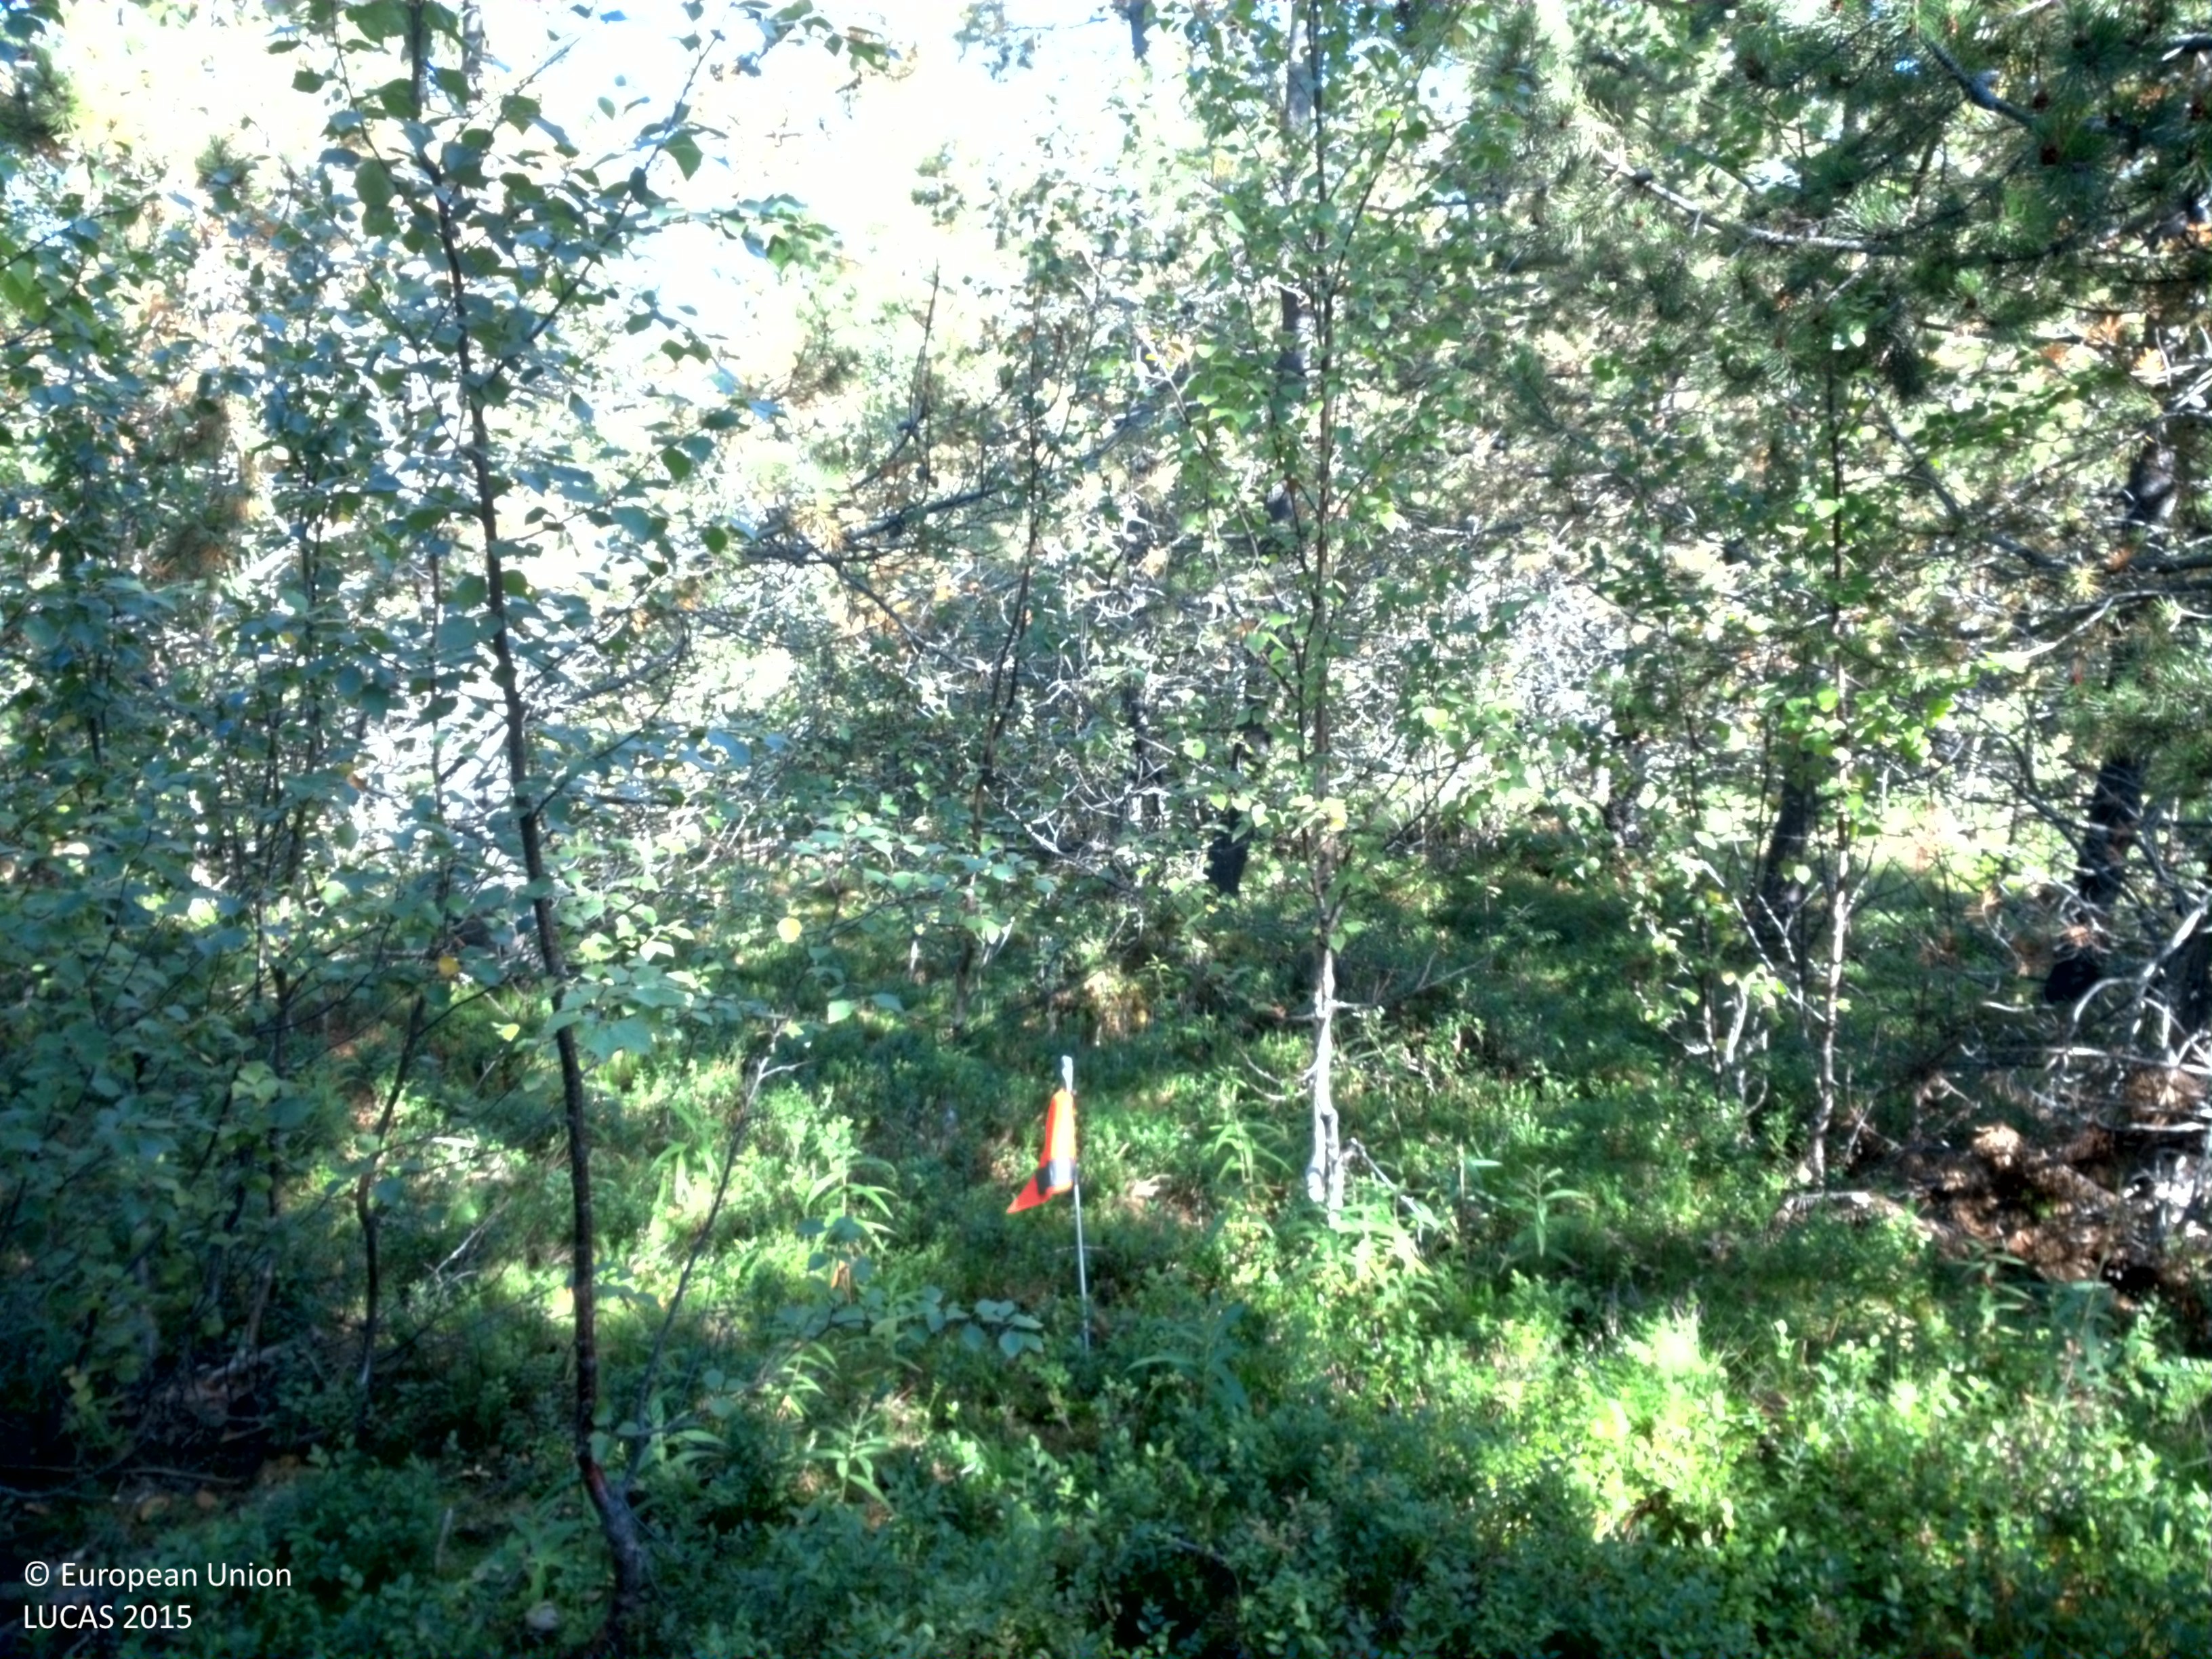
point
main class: Woodland
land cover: Pine dominated mixed woodland
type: exotic forest
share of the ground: 50 - 75 %
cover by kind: coniferous forest trees 35 %, shrubs 25 %, herbaceous plants 20 %, broadleaved forest trees 15 %, lichens and mosses 5 %
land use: Forestry
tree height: > 5 m
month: September
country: SE
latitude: 65.0614
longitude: 16.5322
